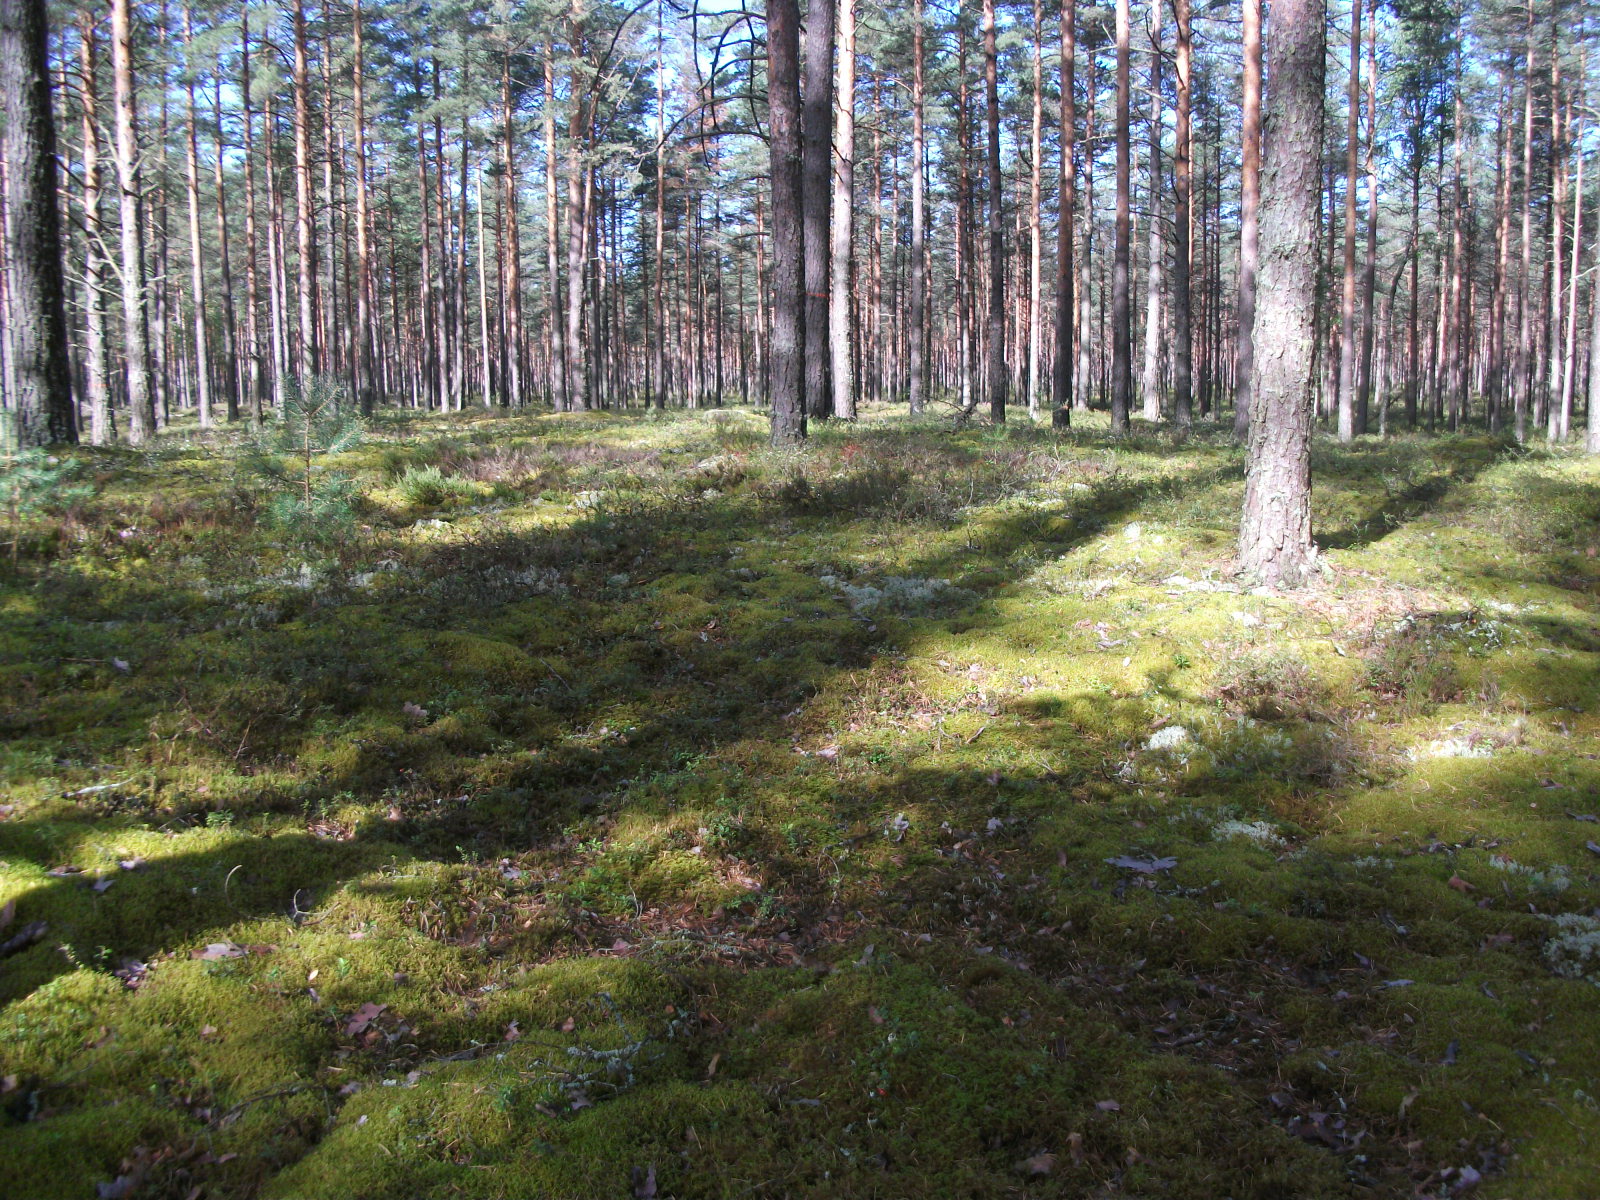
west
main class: Woodland
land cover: Pine dominated coniferous woodland
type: hemiboreal forest and nemoral coniferous forest and mixed broadleaved-coniferous forest
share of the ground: 50 - 75 %
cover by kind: coniferous forest trees 65 %, lichens and mosses 35 %
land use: Forestry
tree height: > 5 m
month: August
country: LV
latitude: 56.5058
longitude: 26.5097
